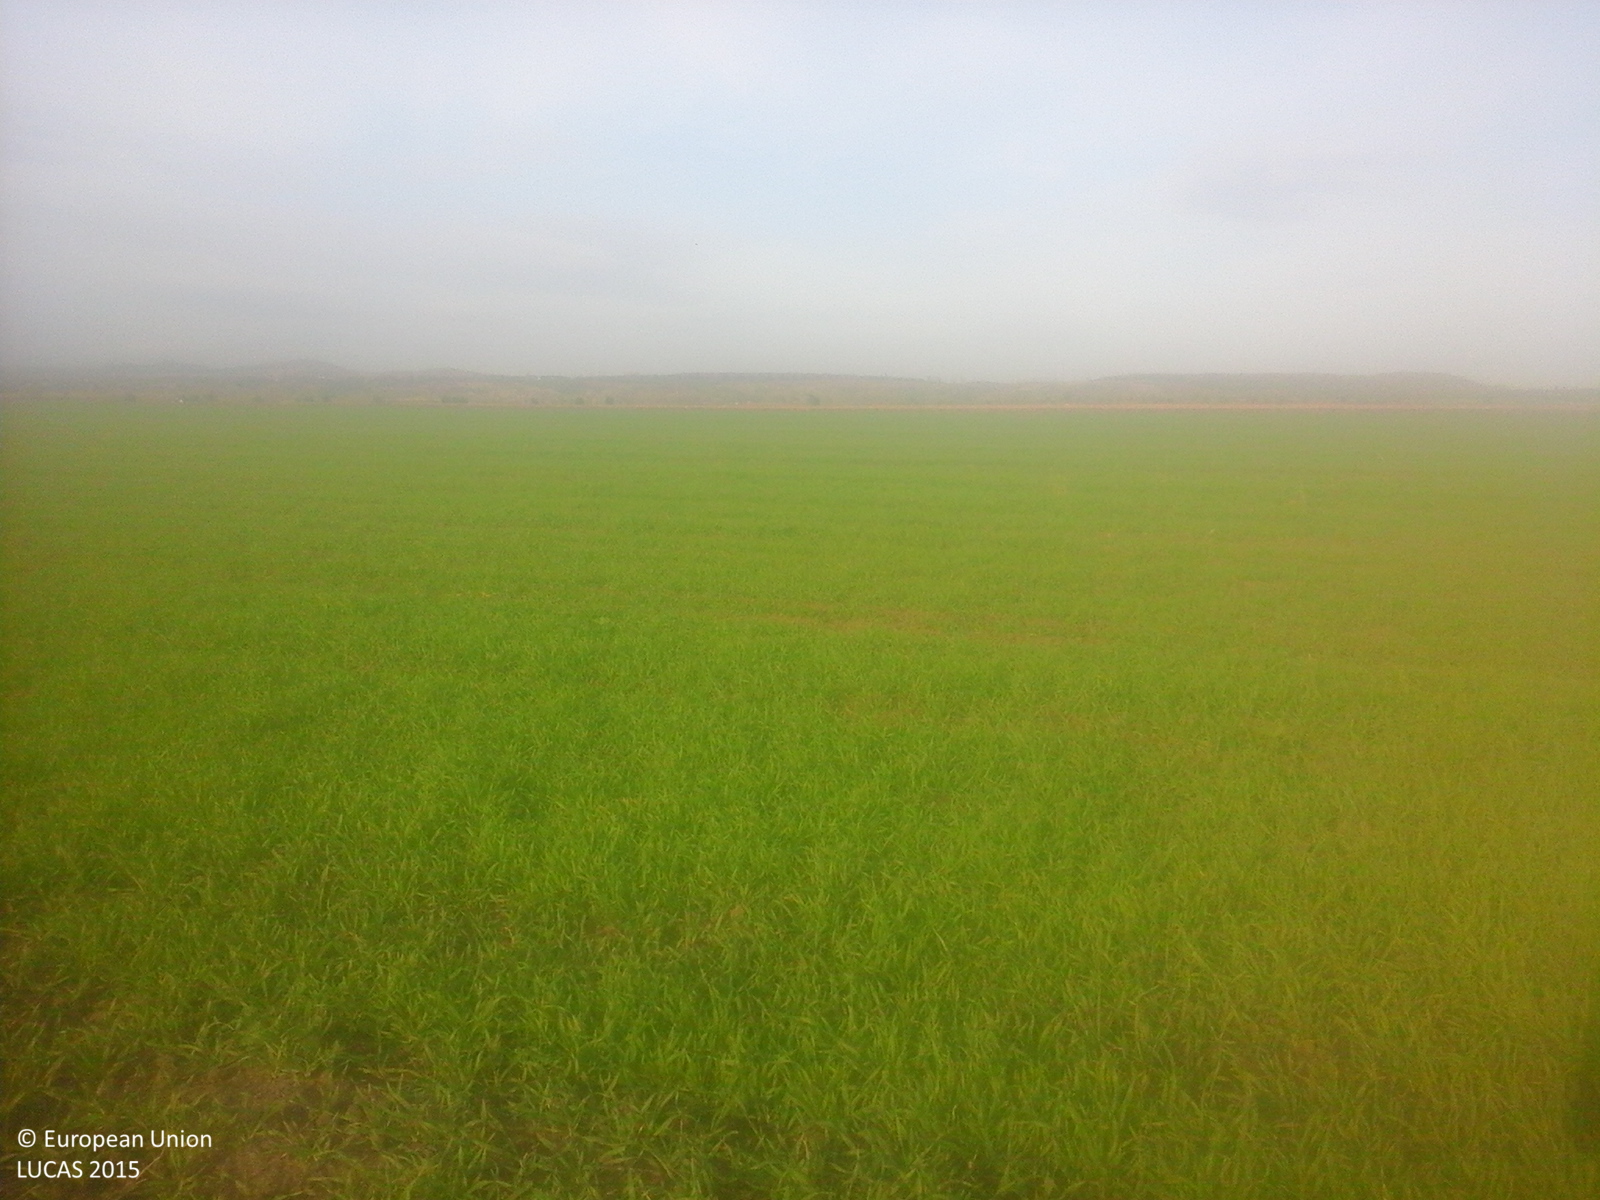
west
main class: Cropland
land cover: Common wheat
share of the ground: > 75 %
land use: Agriculture (excluding fallow land and kitchen gardens)
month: October
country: RO
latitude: 45.4466
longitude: 27.0554
